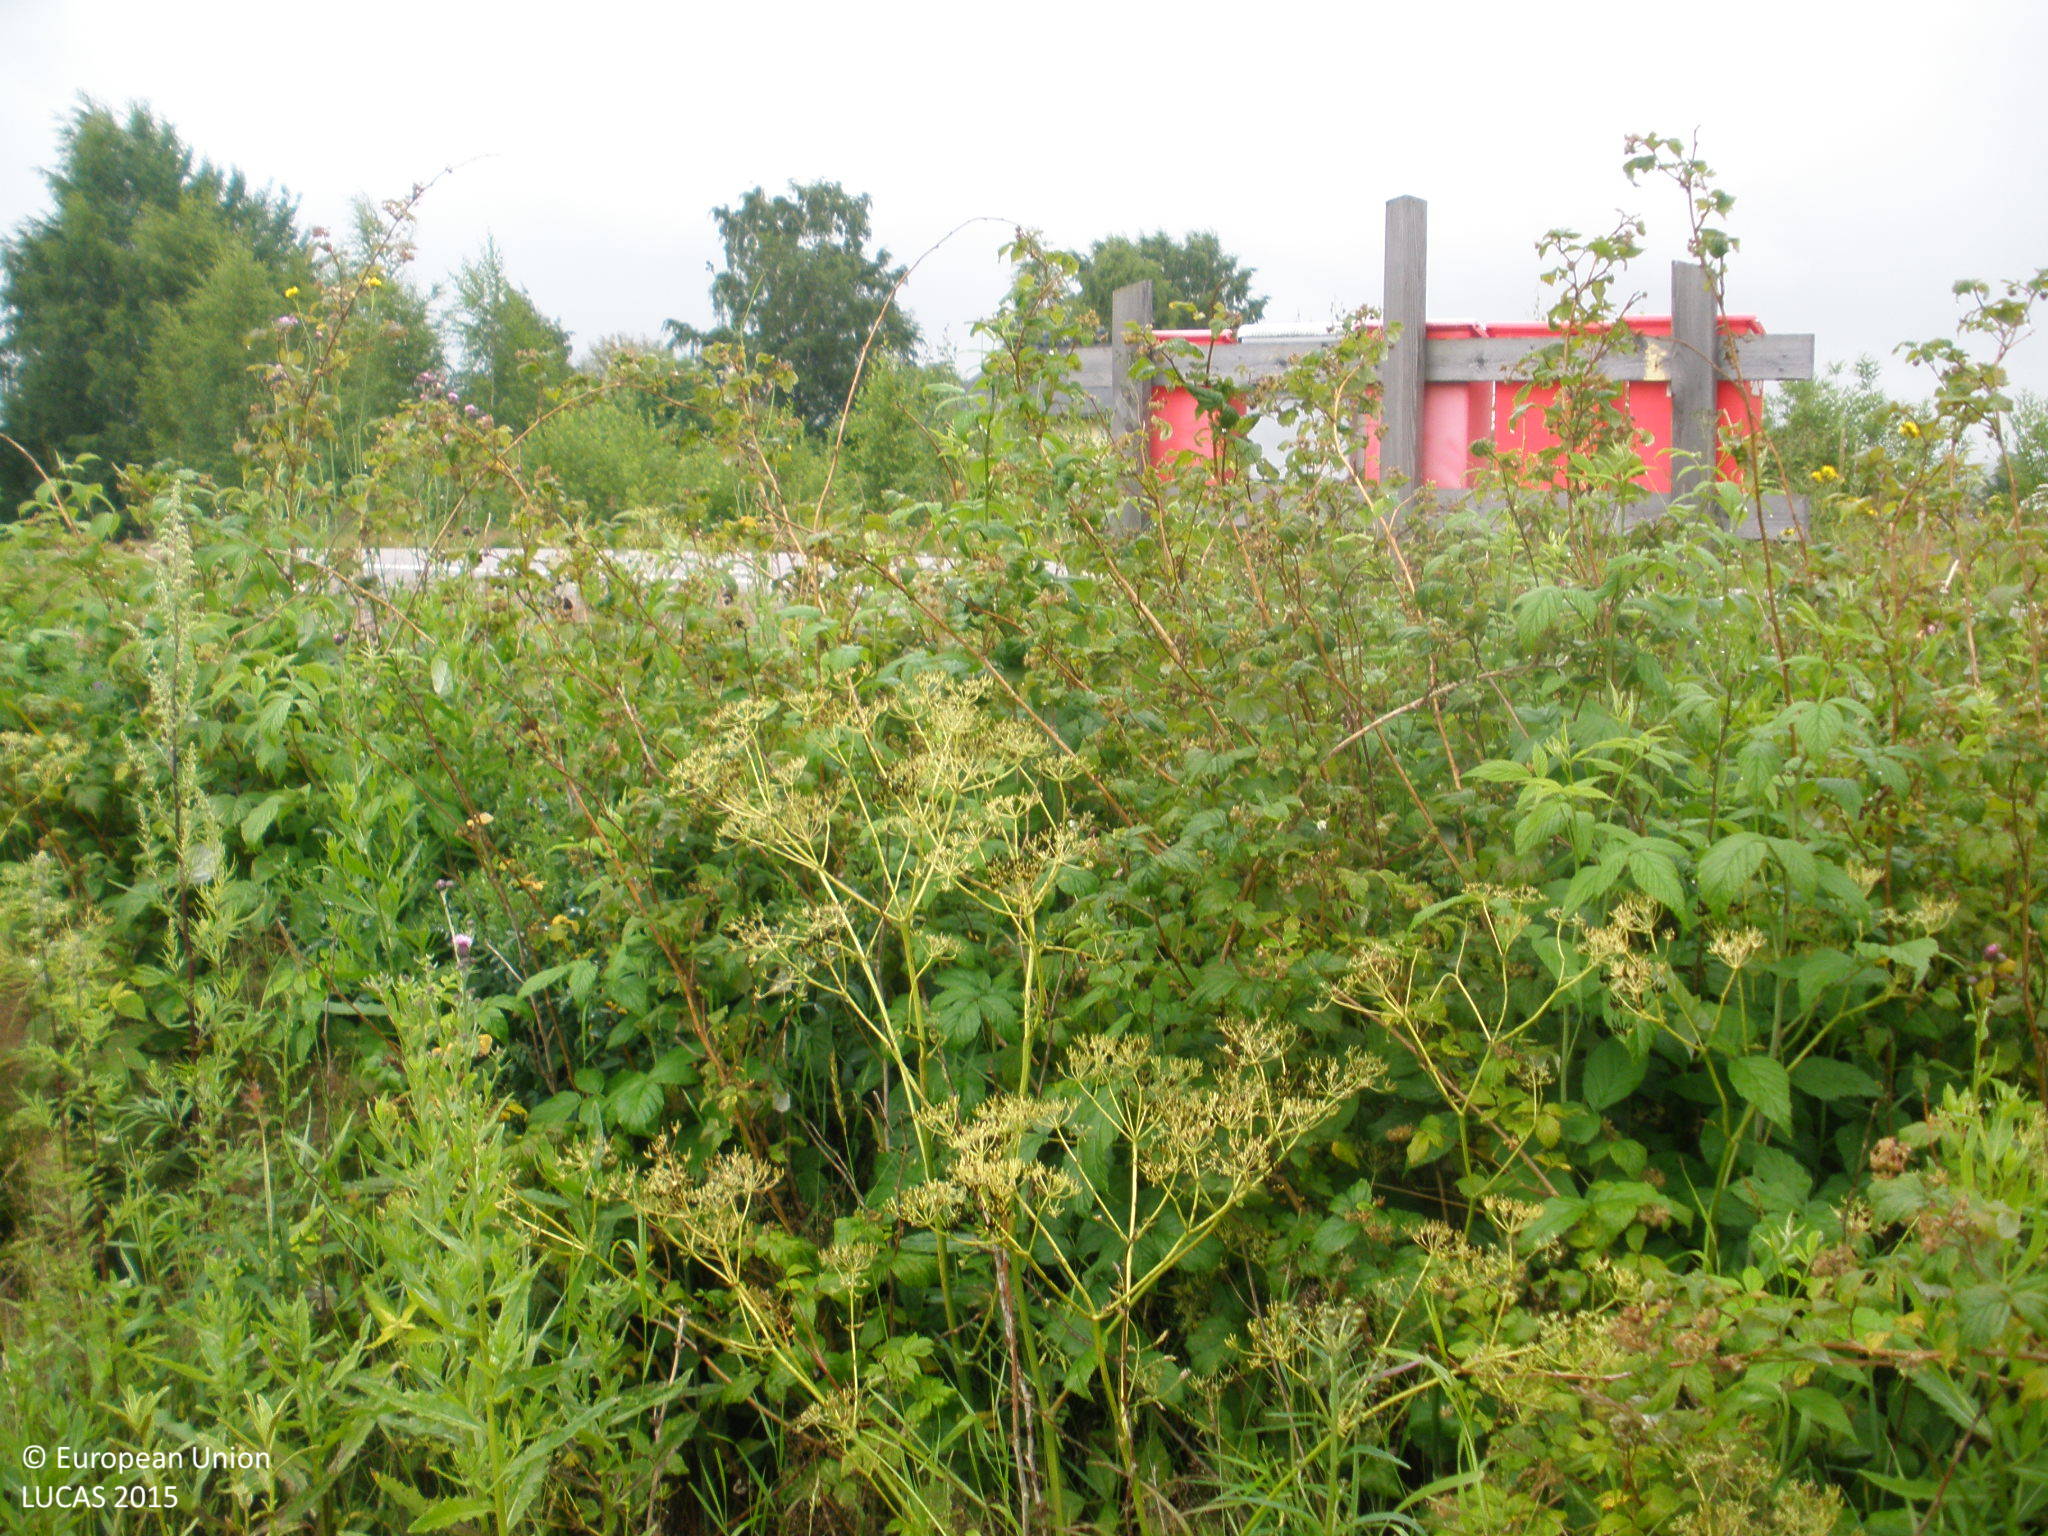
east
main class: Cropland
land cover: Barley
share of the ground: 25 - 50 %
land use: Agriculture (excluding fallow land and kitchen gardens)
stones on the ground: < 10 %
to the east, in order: Barley; Shruby margins; Tracks; Shruby margins; Paved roads, cycling and walking lanes; Shruby margins; Ditches and canals; Broadleaved woodland; Artificial constructions in urban areas; Spontaneously vegetated surfaces; Rape and turnip rape; Grassland without tree/shrub cover
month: July
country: FI
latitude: 61.1606
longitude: 24.7705
